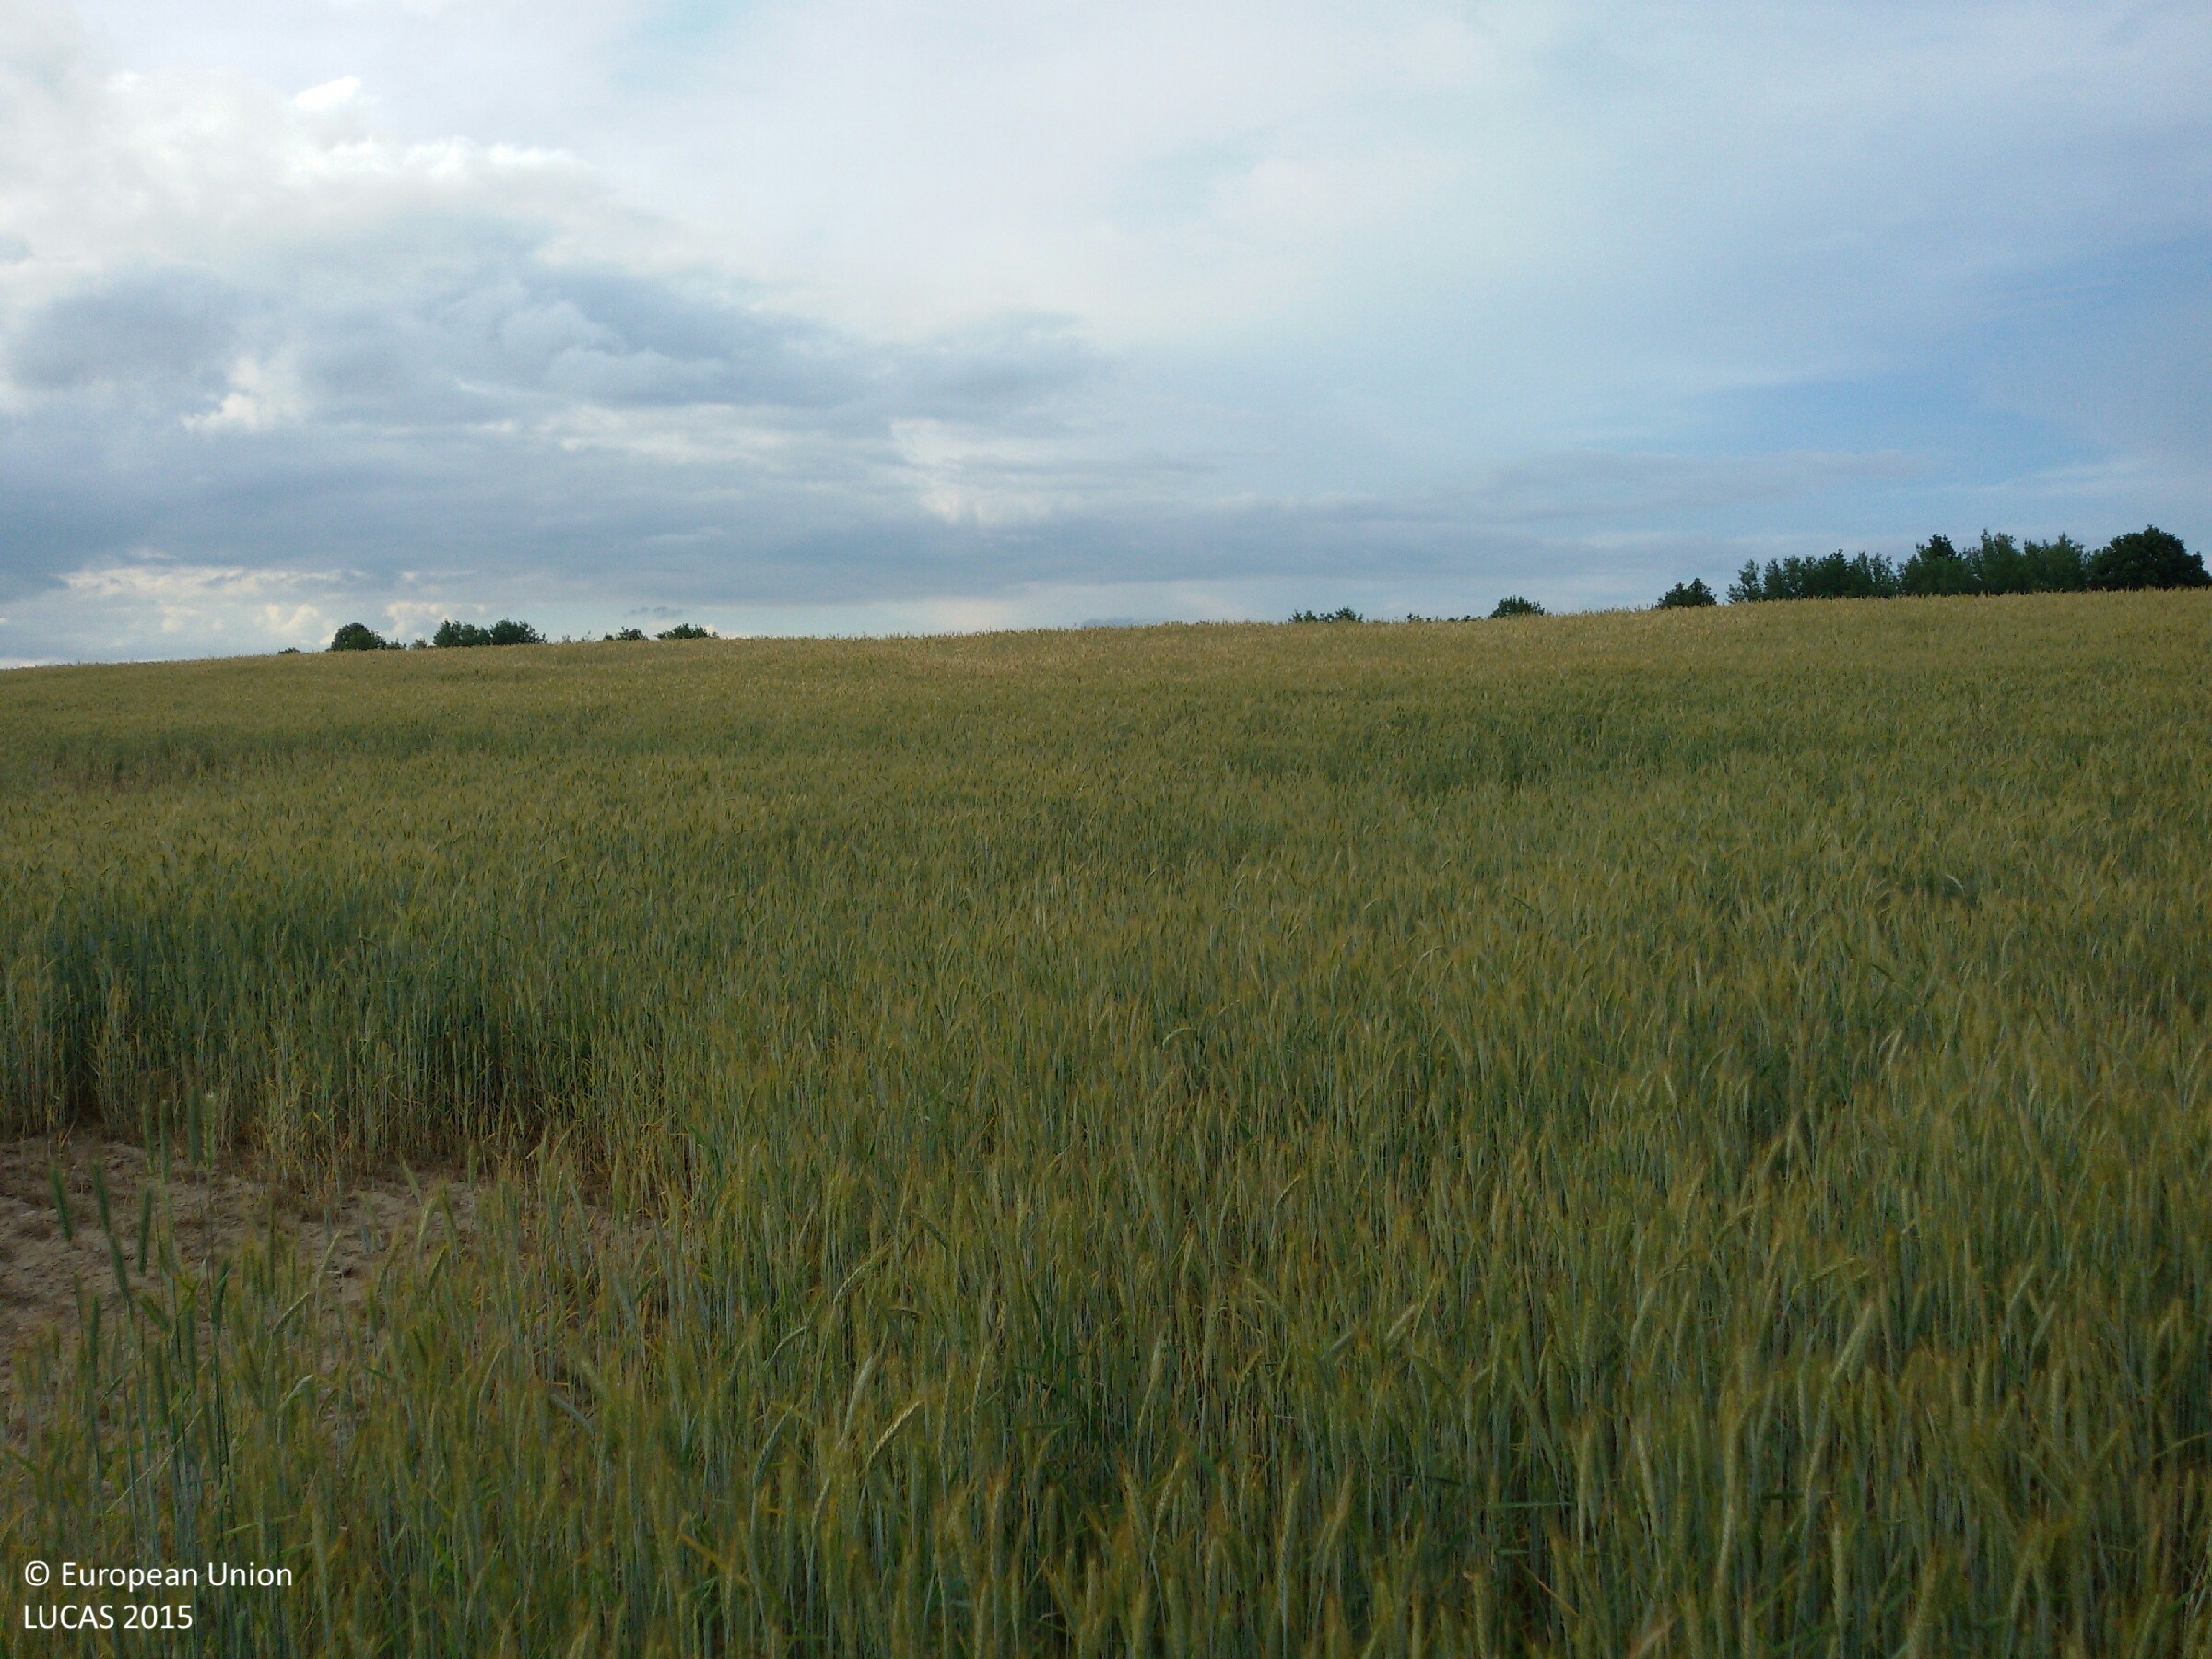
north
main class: Cropland
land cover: Common wheat
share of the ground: > 75 %
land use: Agriculture (excluding fallow land and kitchen gardens)
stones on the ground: < 10 %
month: June
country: PL
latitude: 53.4468
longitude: 20.1362
